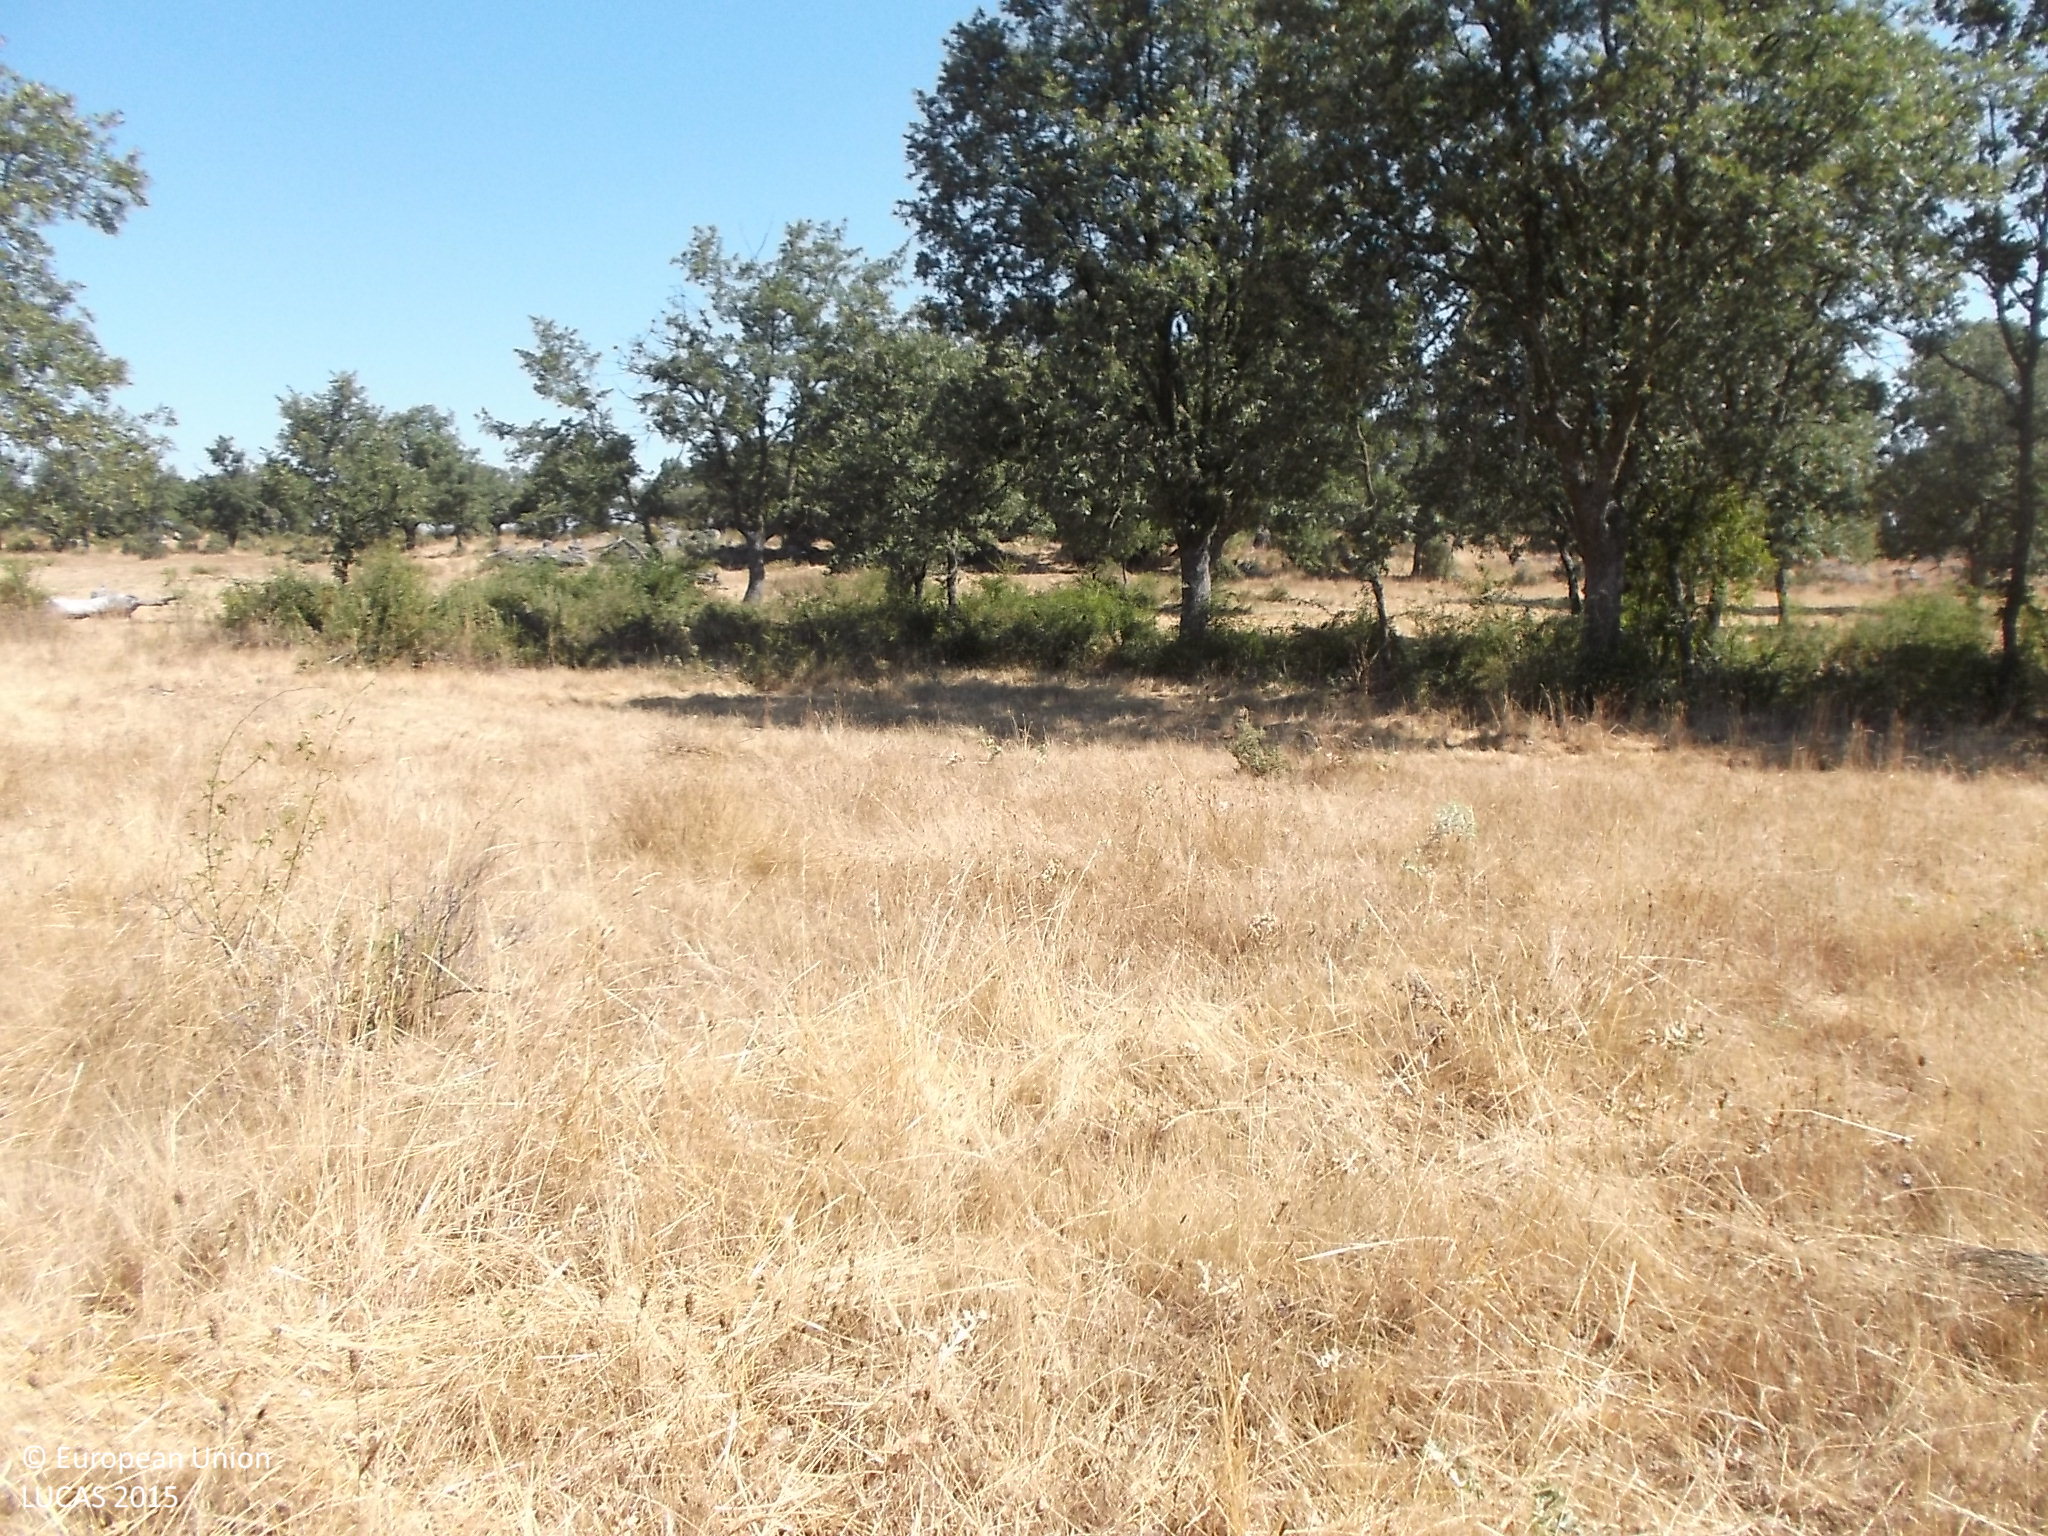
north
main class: Woodland
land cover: Broadleaved woodland
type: broadleaved evergreen forest
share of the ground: 10 - 25 %
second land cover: Shrubland without tree cover
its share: 25 - 50 %
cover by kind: shrubs 40 %, herbaceous plants 35 %, broadleaved forest trees 25 %
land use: Forestry
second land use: Agriculture (excluding fallow land and kitchen gardens)
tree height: < 5 m
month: July
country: ES
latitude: 41.3543
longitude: -5.9987
